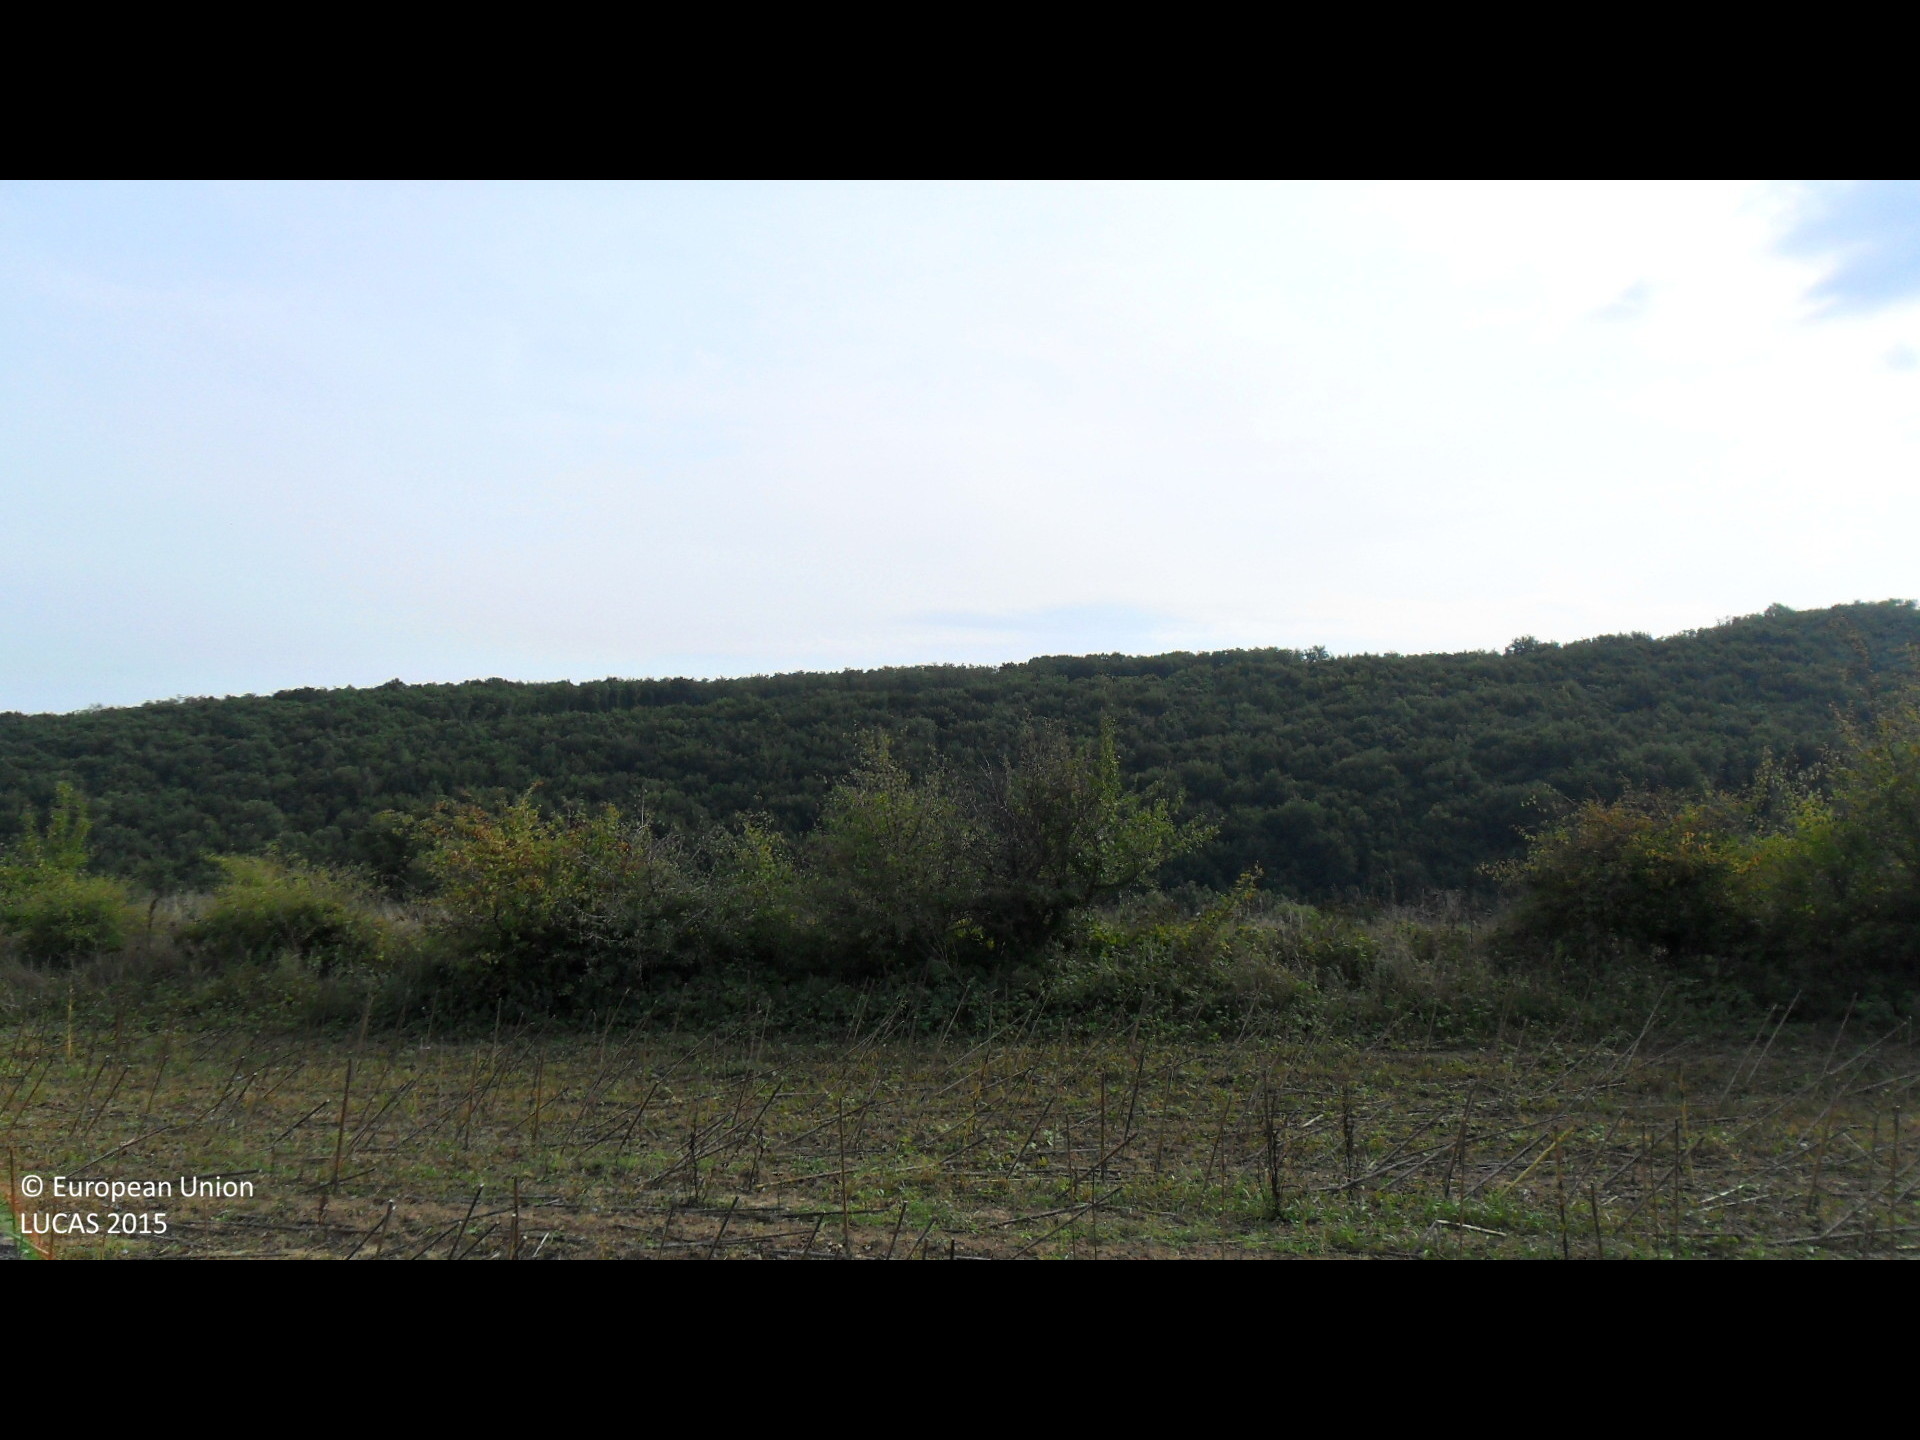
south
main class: Cropland
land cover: Sunflower
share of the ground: 25 - 50 %
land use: Agriculture (excluding fallow land and kitchen gardens)
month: September
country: BG
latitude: 43.0472
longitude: 26.4372
